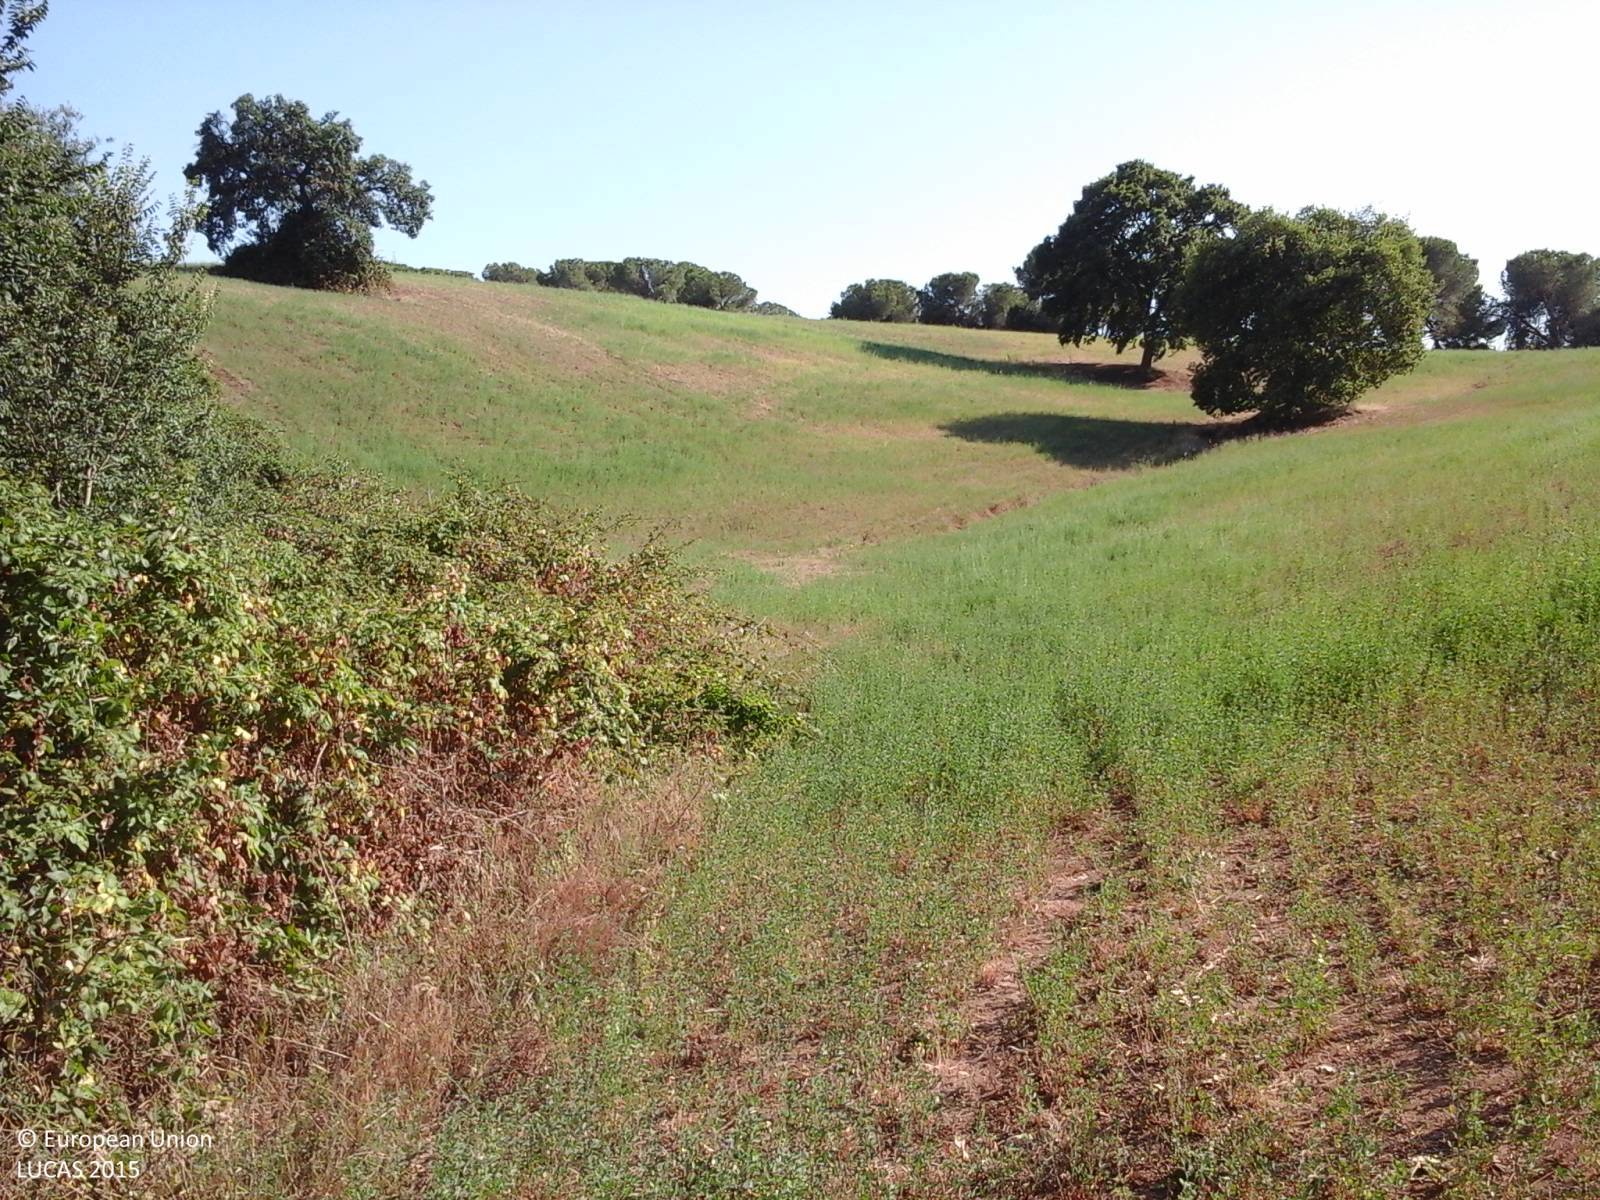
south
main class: Woodland
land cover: Broadleaved woodland
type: thermophilous deciduous forest
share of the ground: > 75 %
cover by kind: broadleaved forest trees 75 %, shrubs 25 %
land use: Forestry
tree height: > 5 m
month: July
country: IT
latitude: 42.0252
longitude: 12.5632
